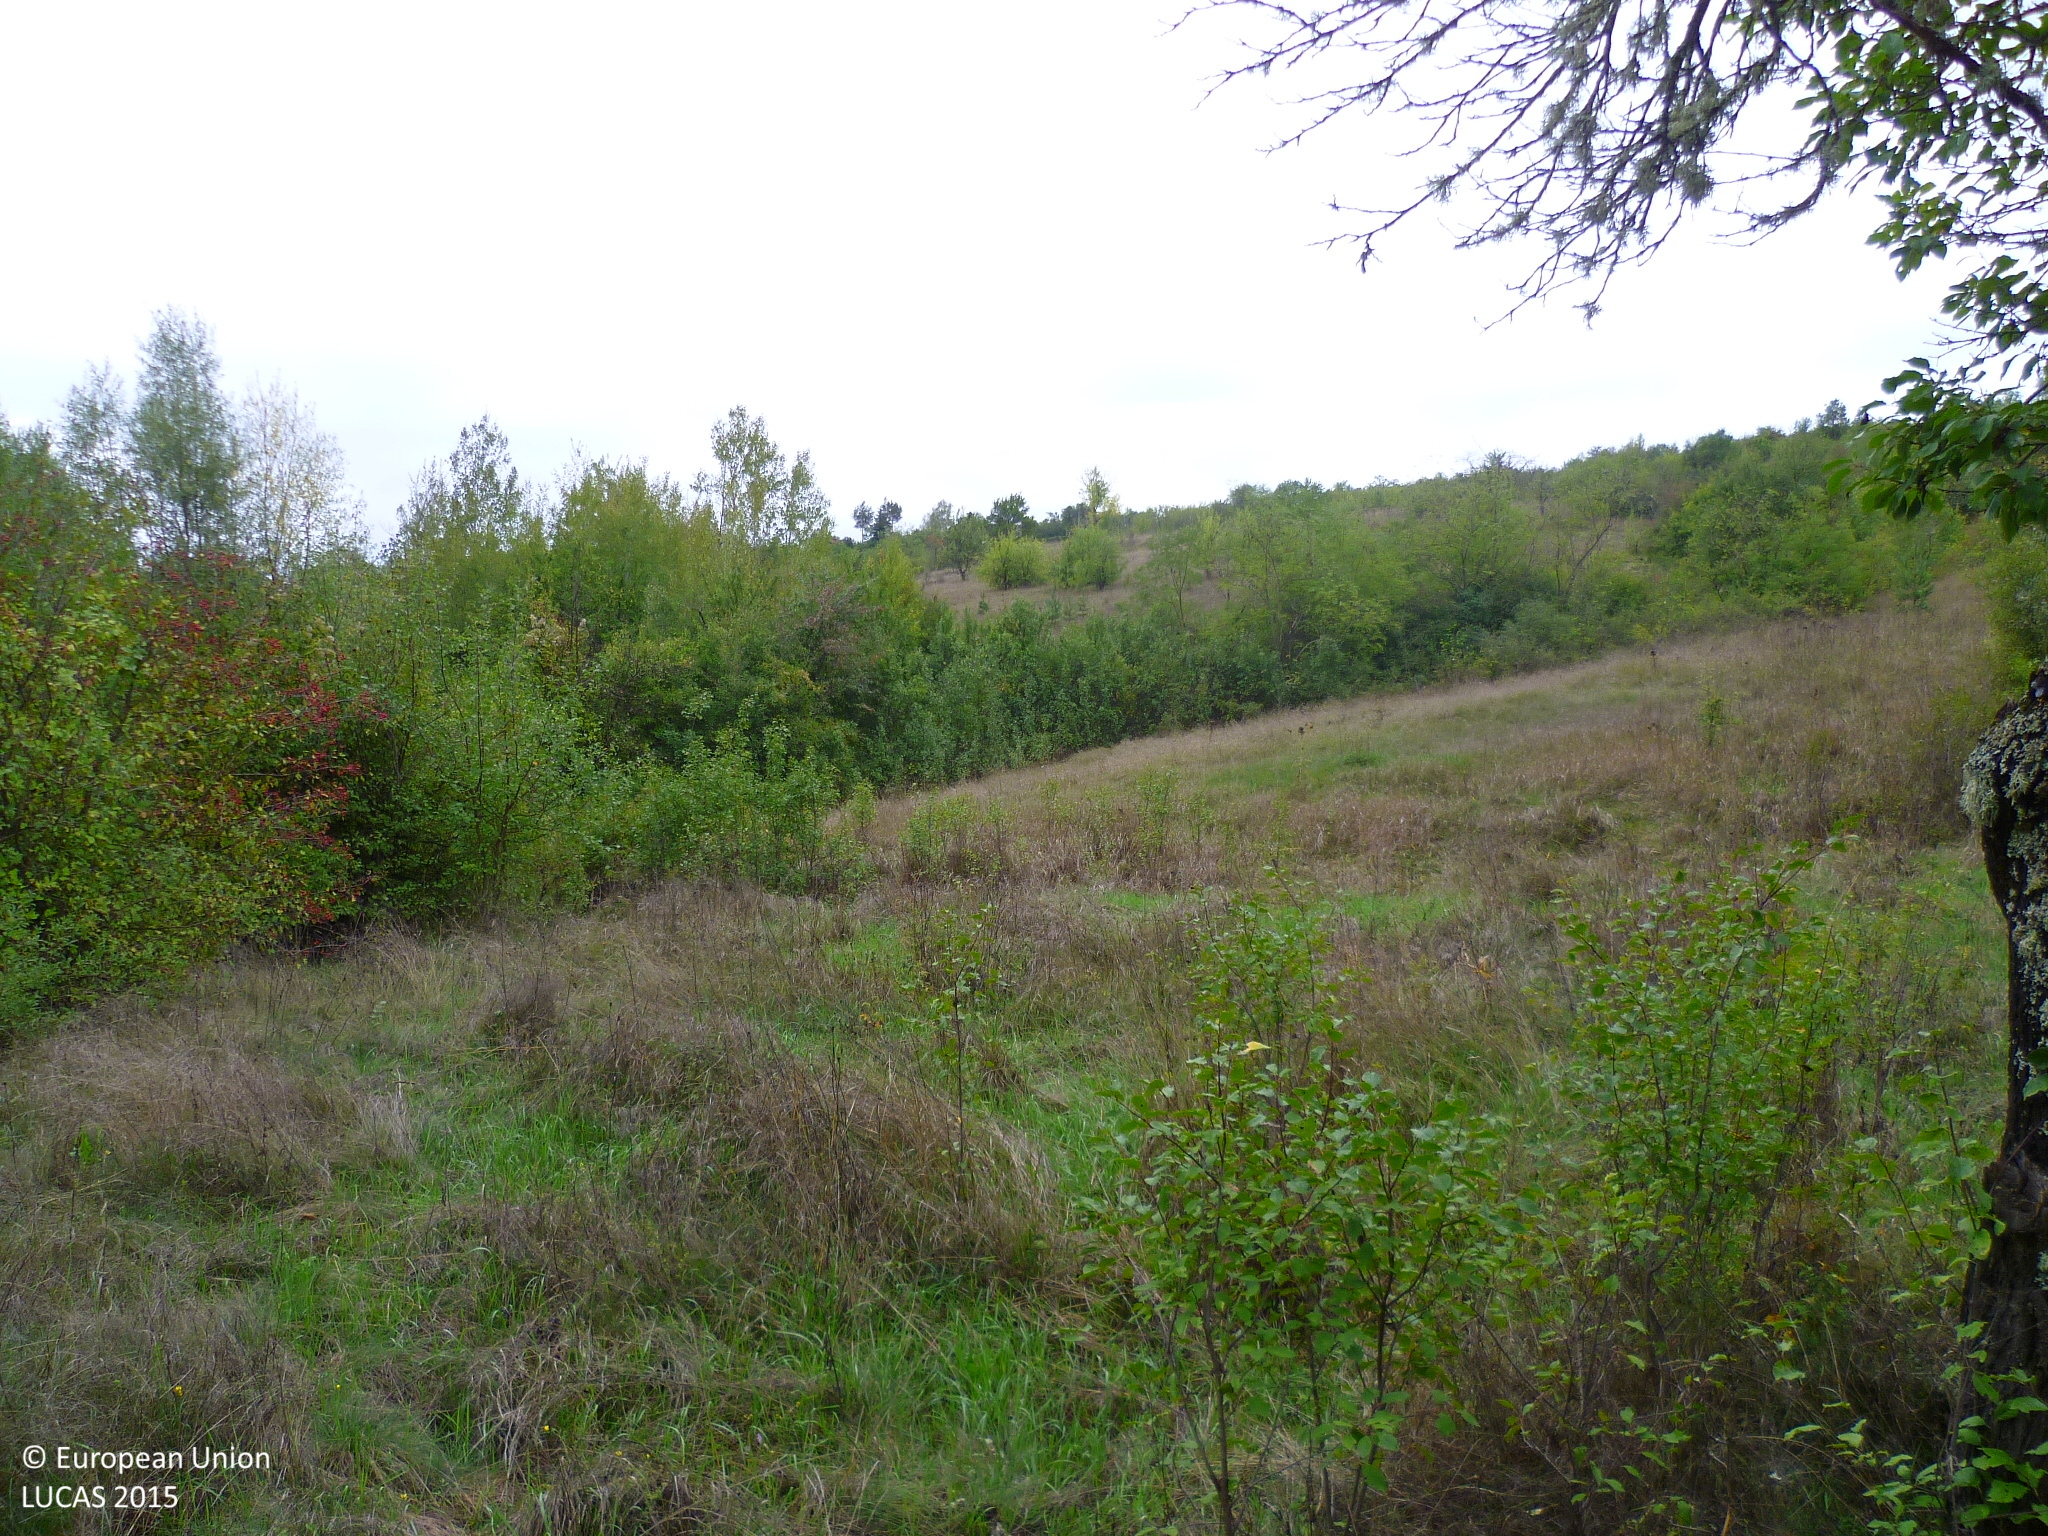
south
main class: Grassland
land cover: Grassland with sparse tree/shrub cover
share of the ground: > 75 %
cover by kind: herbaceous plants 90 %, broadleaved forest trees 5 %, shrubs 5 %
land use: Agriculture (excluding fallow land and kitchen gardens)
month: September
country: BG
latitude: 42.5833
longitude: 22.6844
